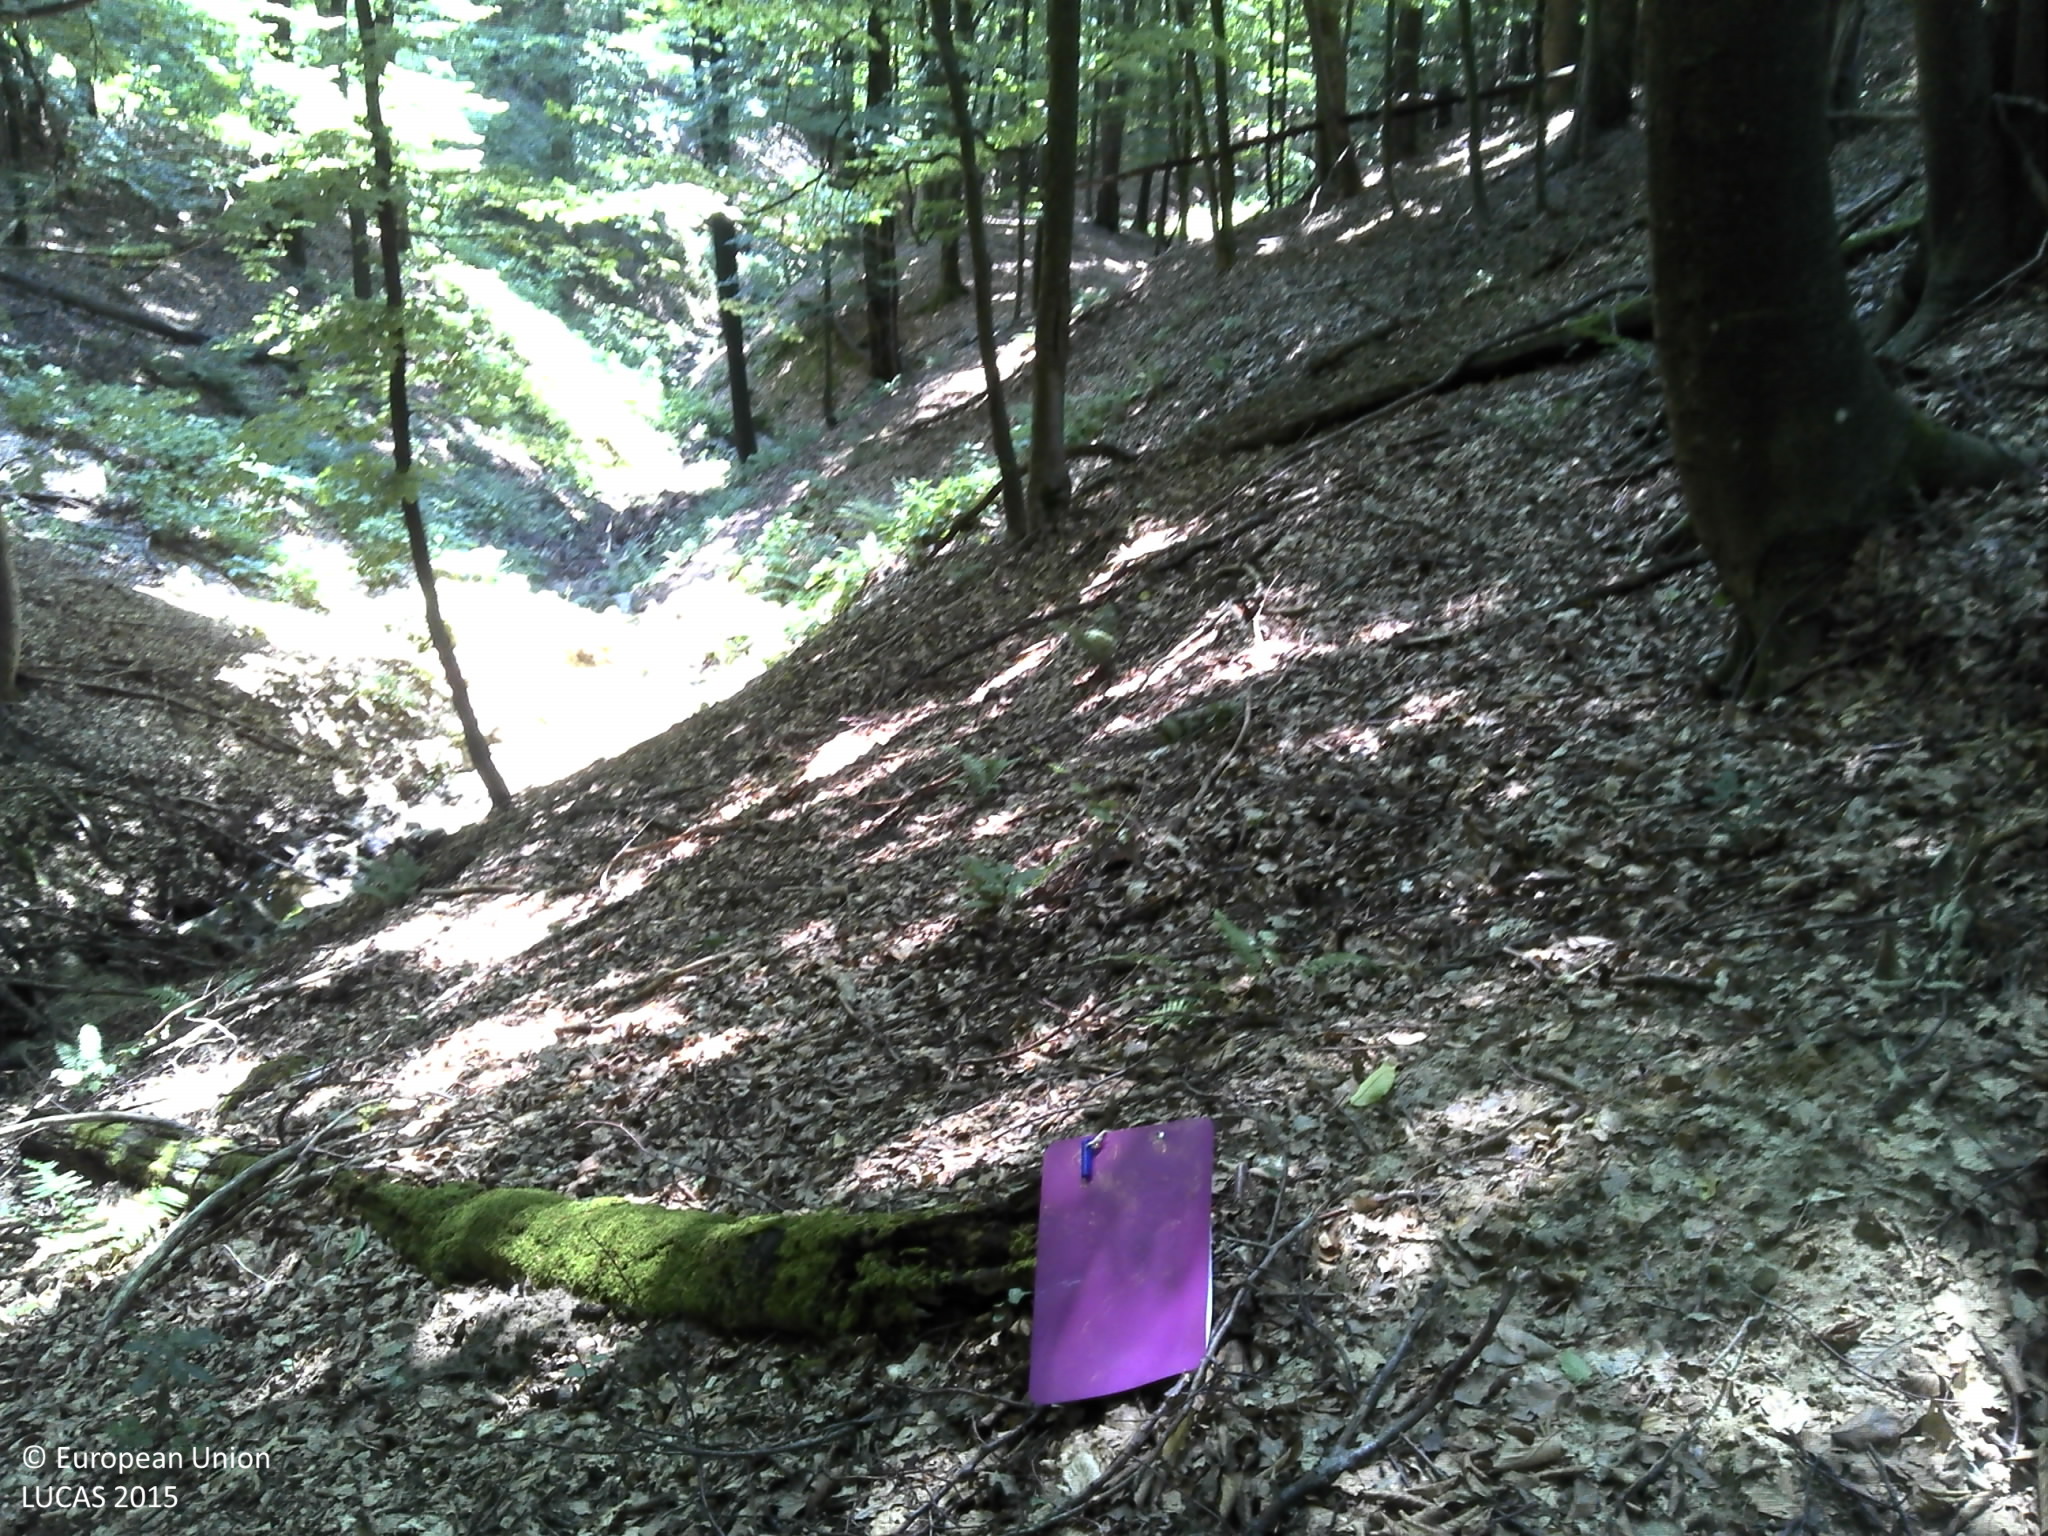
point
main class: Woodland
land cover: Broadleaved woodland
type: beech forest
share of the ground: > 75 %
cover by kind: broadleaved forest trees 80 %, lichens and mosses 20 %
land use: Forestry
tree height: > 5 m
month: July
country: HR
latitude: 45.6149
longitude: 16.7317
